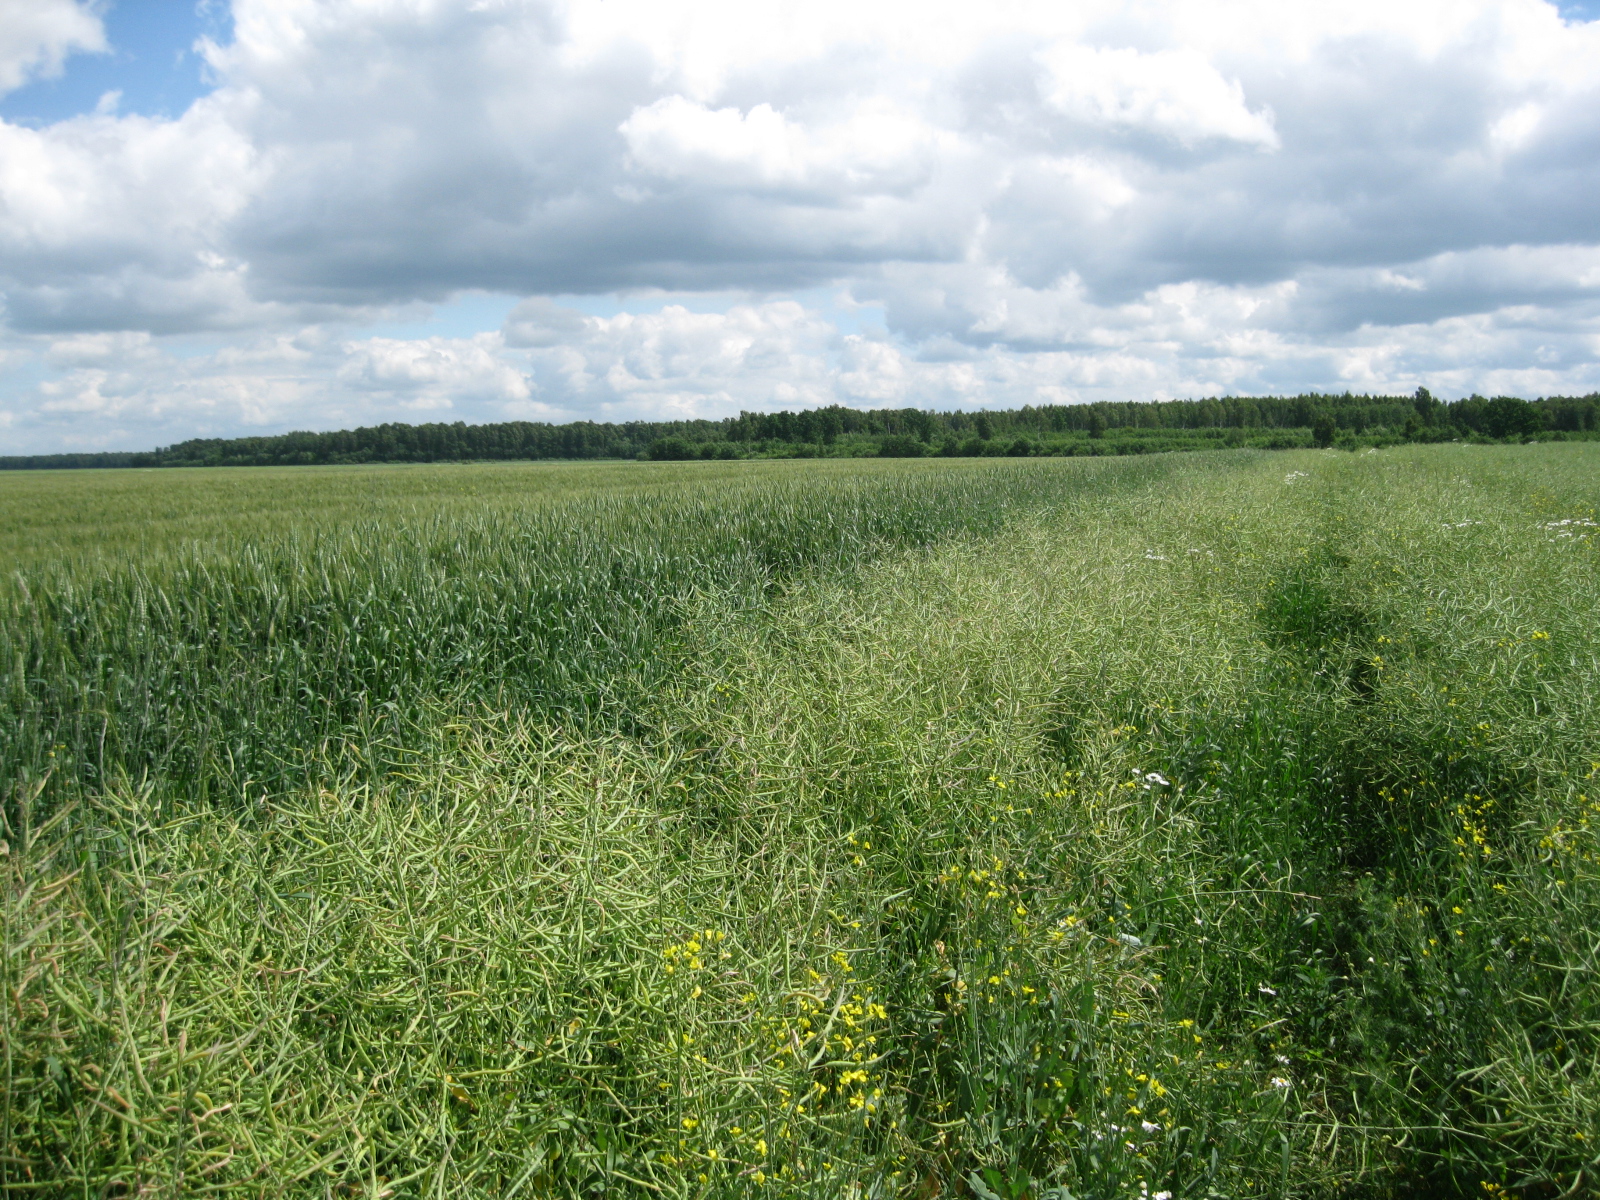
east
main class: Cropland
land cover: Rape and turnip rape
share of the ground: > 75 %
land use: Agriculture (excluding fallow land and kitchen gardens)
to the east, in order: Rape and turnip rape
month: June
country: LT
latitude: 55.5760
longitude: 24.1937
